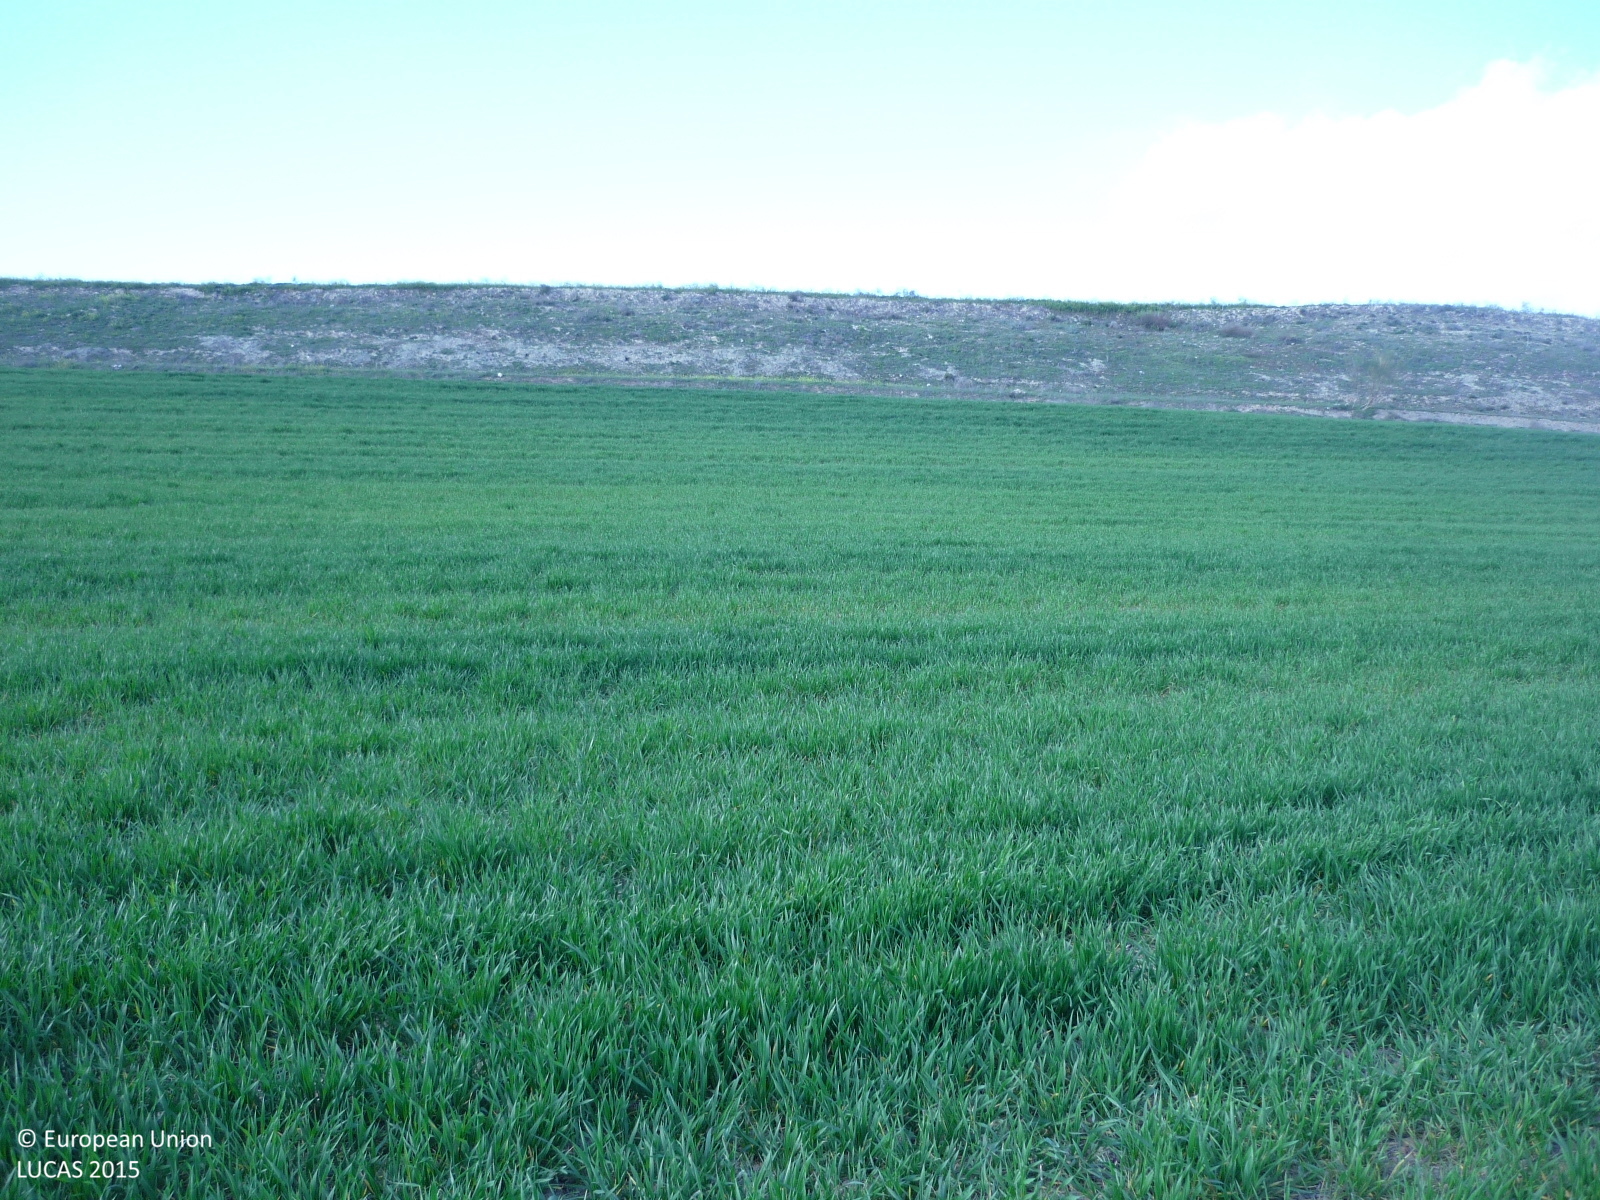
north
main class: Cropland
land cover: Barley
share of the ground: > 75 %
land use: Agriculture (excluding fallow land and kitchen gardens)
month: March
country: ES
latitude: 40.4045
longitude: -3.4073
